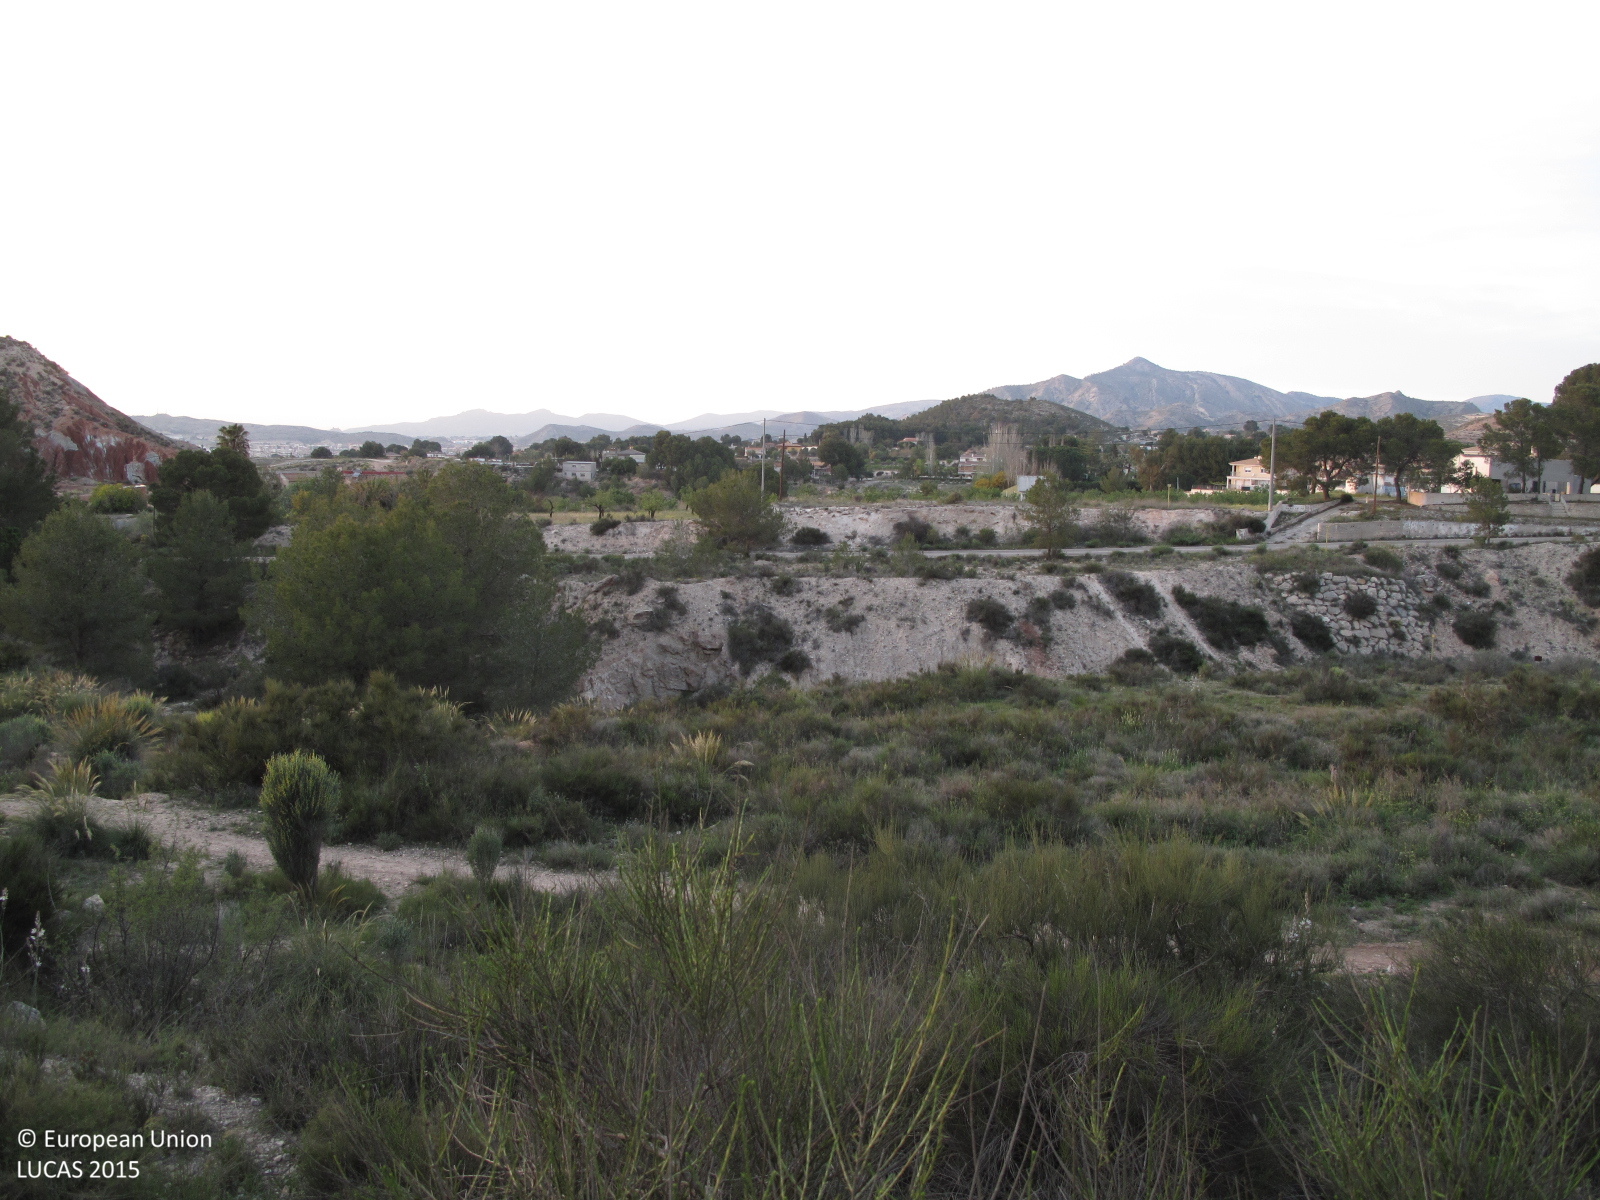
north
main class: Shrubland
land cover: Shrubland without tree cover
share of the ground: 25 - 50 %
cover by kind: herbaceous plants 60 %, shrubs 30 %, consolidated bare surface 10 %
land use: Semi-natural and natural areas not in use
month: April
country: ES
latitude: 38.4498
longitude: -0.7701
